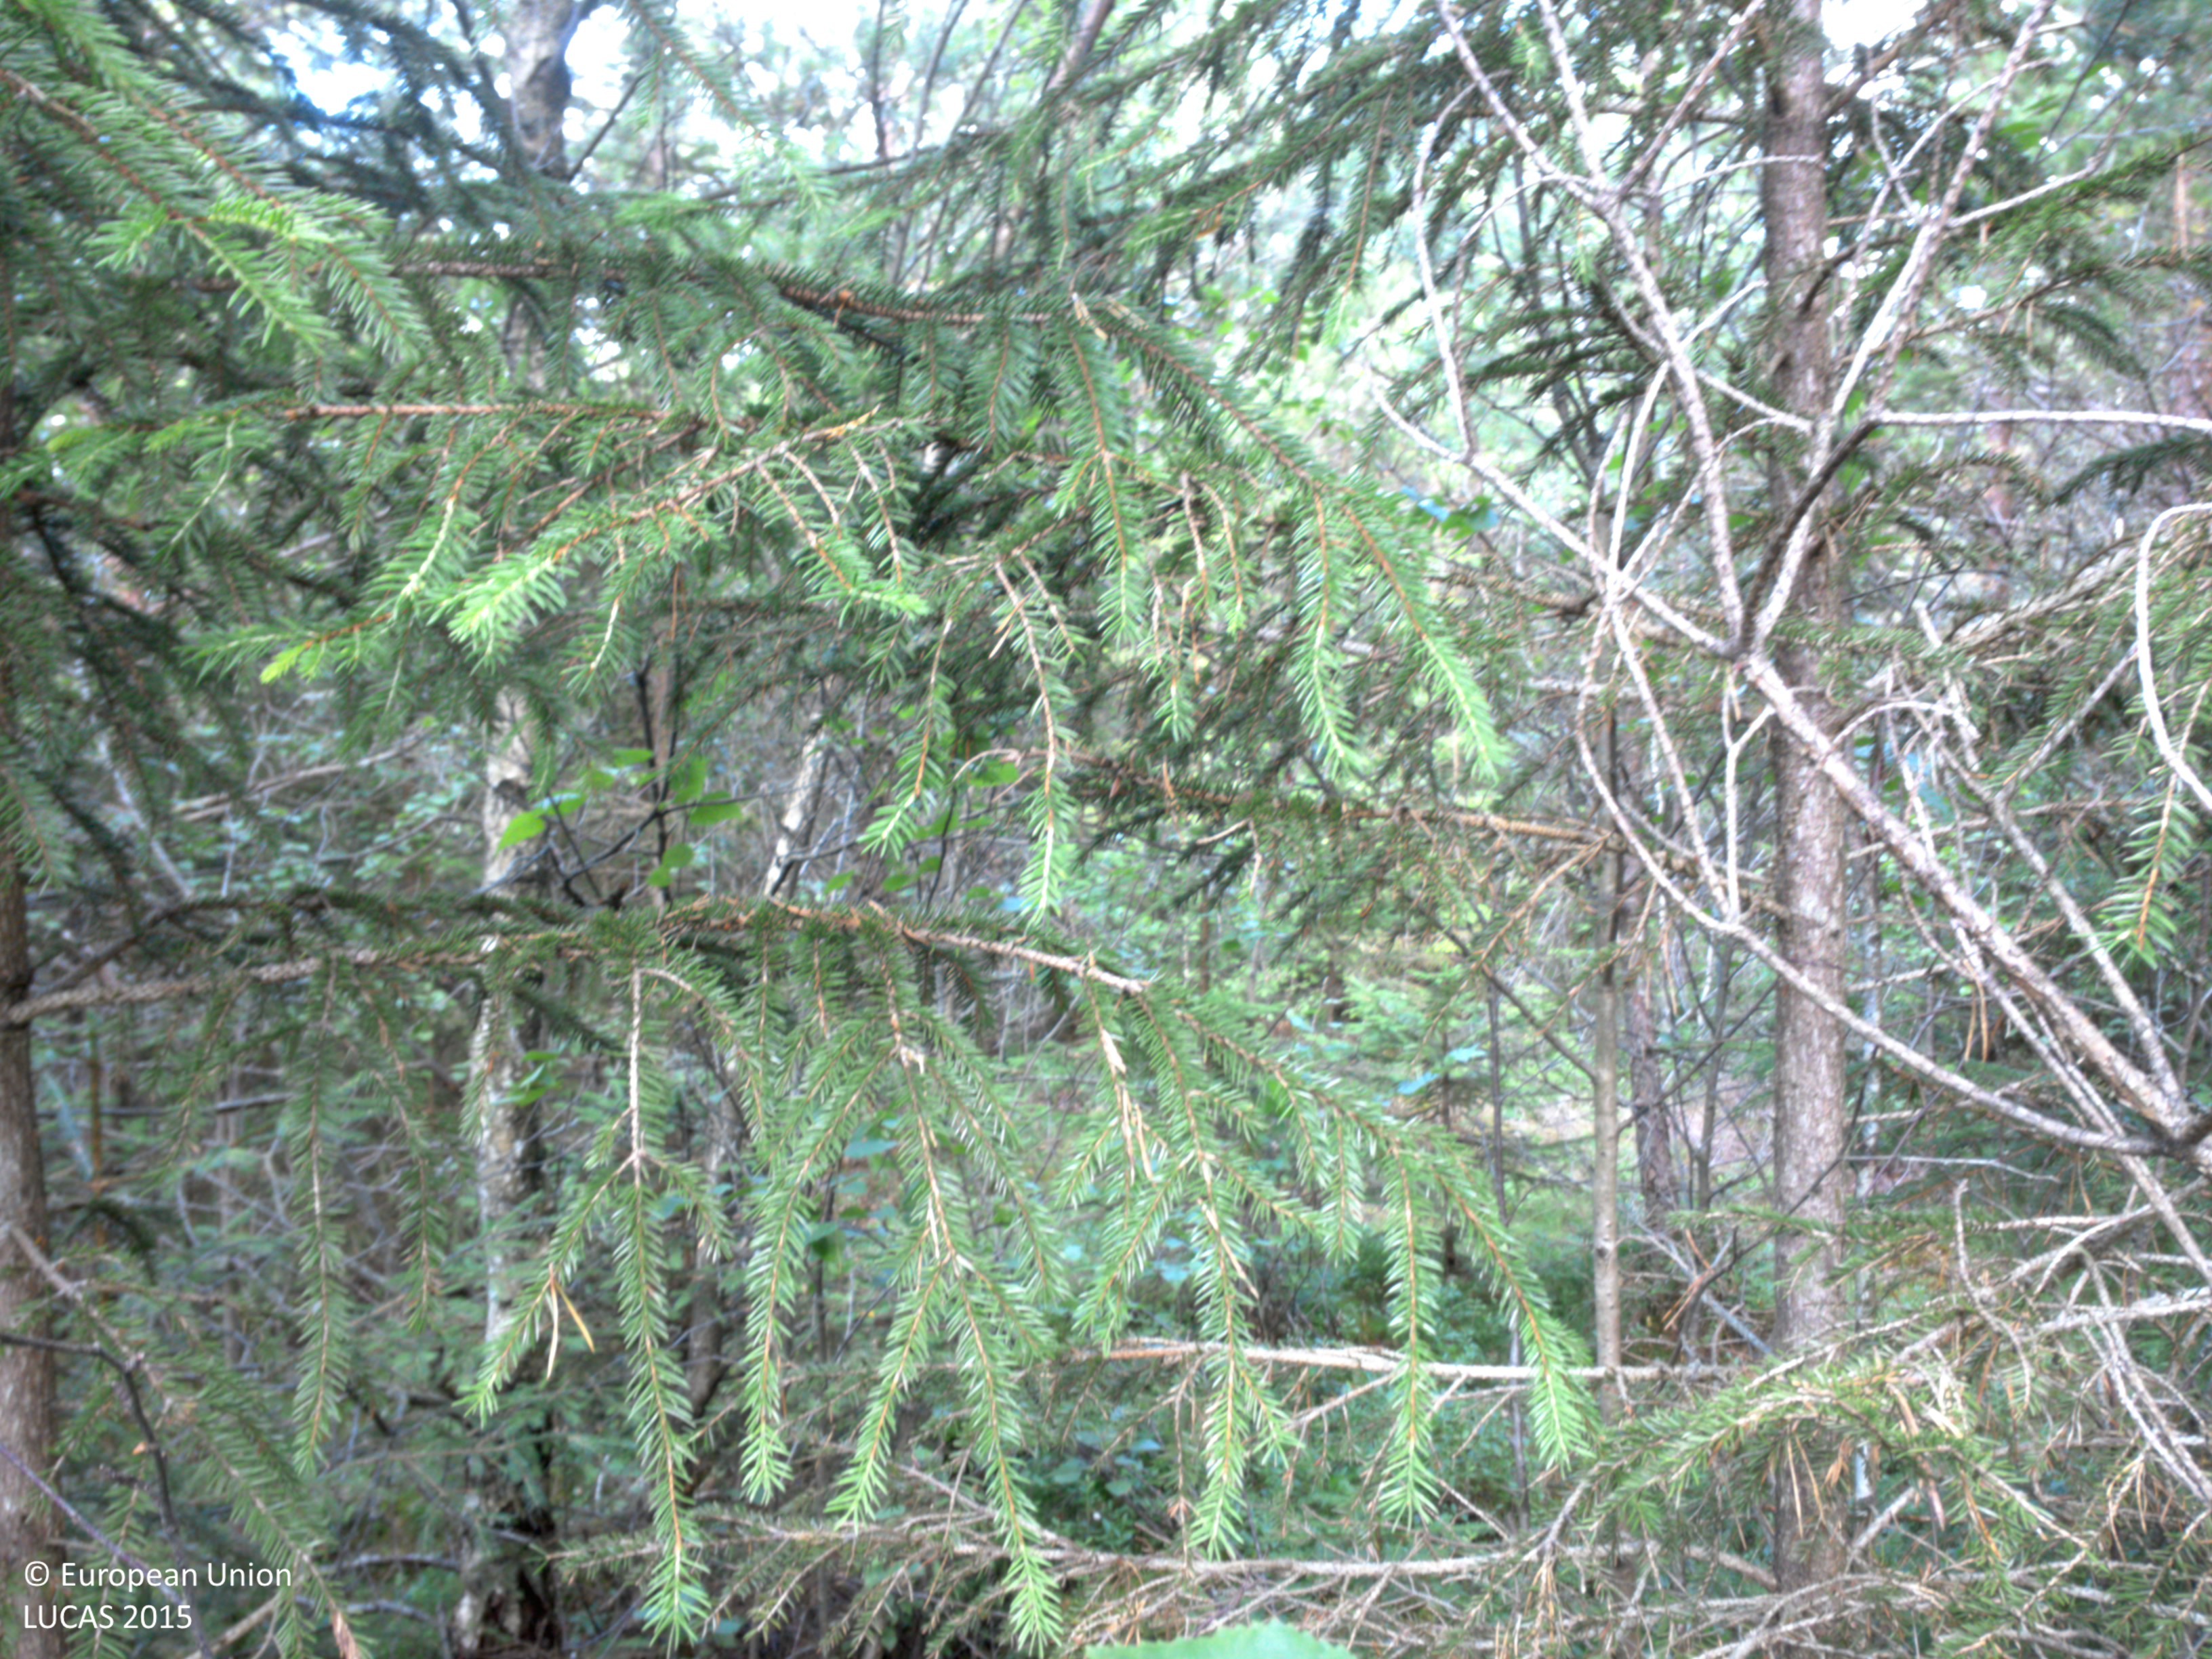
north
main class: Woodland
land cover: Spruce dominated mixed woodland
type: boreal forest
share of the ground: 50 - 75 %
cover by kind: coniferous forest trees 40 %, broadleaved forest trees 30 %, lichens and mosses 20 %, herbaceous plants 10 %
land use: Forestry
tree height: > 5 m
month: July
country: SE
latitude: 58.5865
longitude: 11.6993
